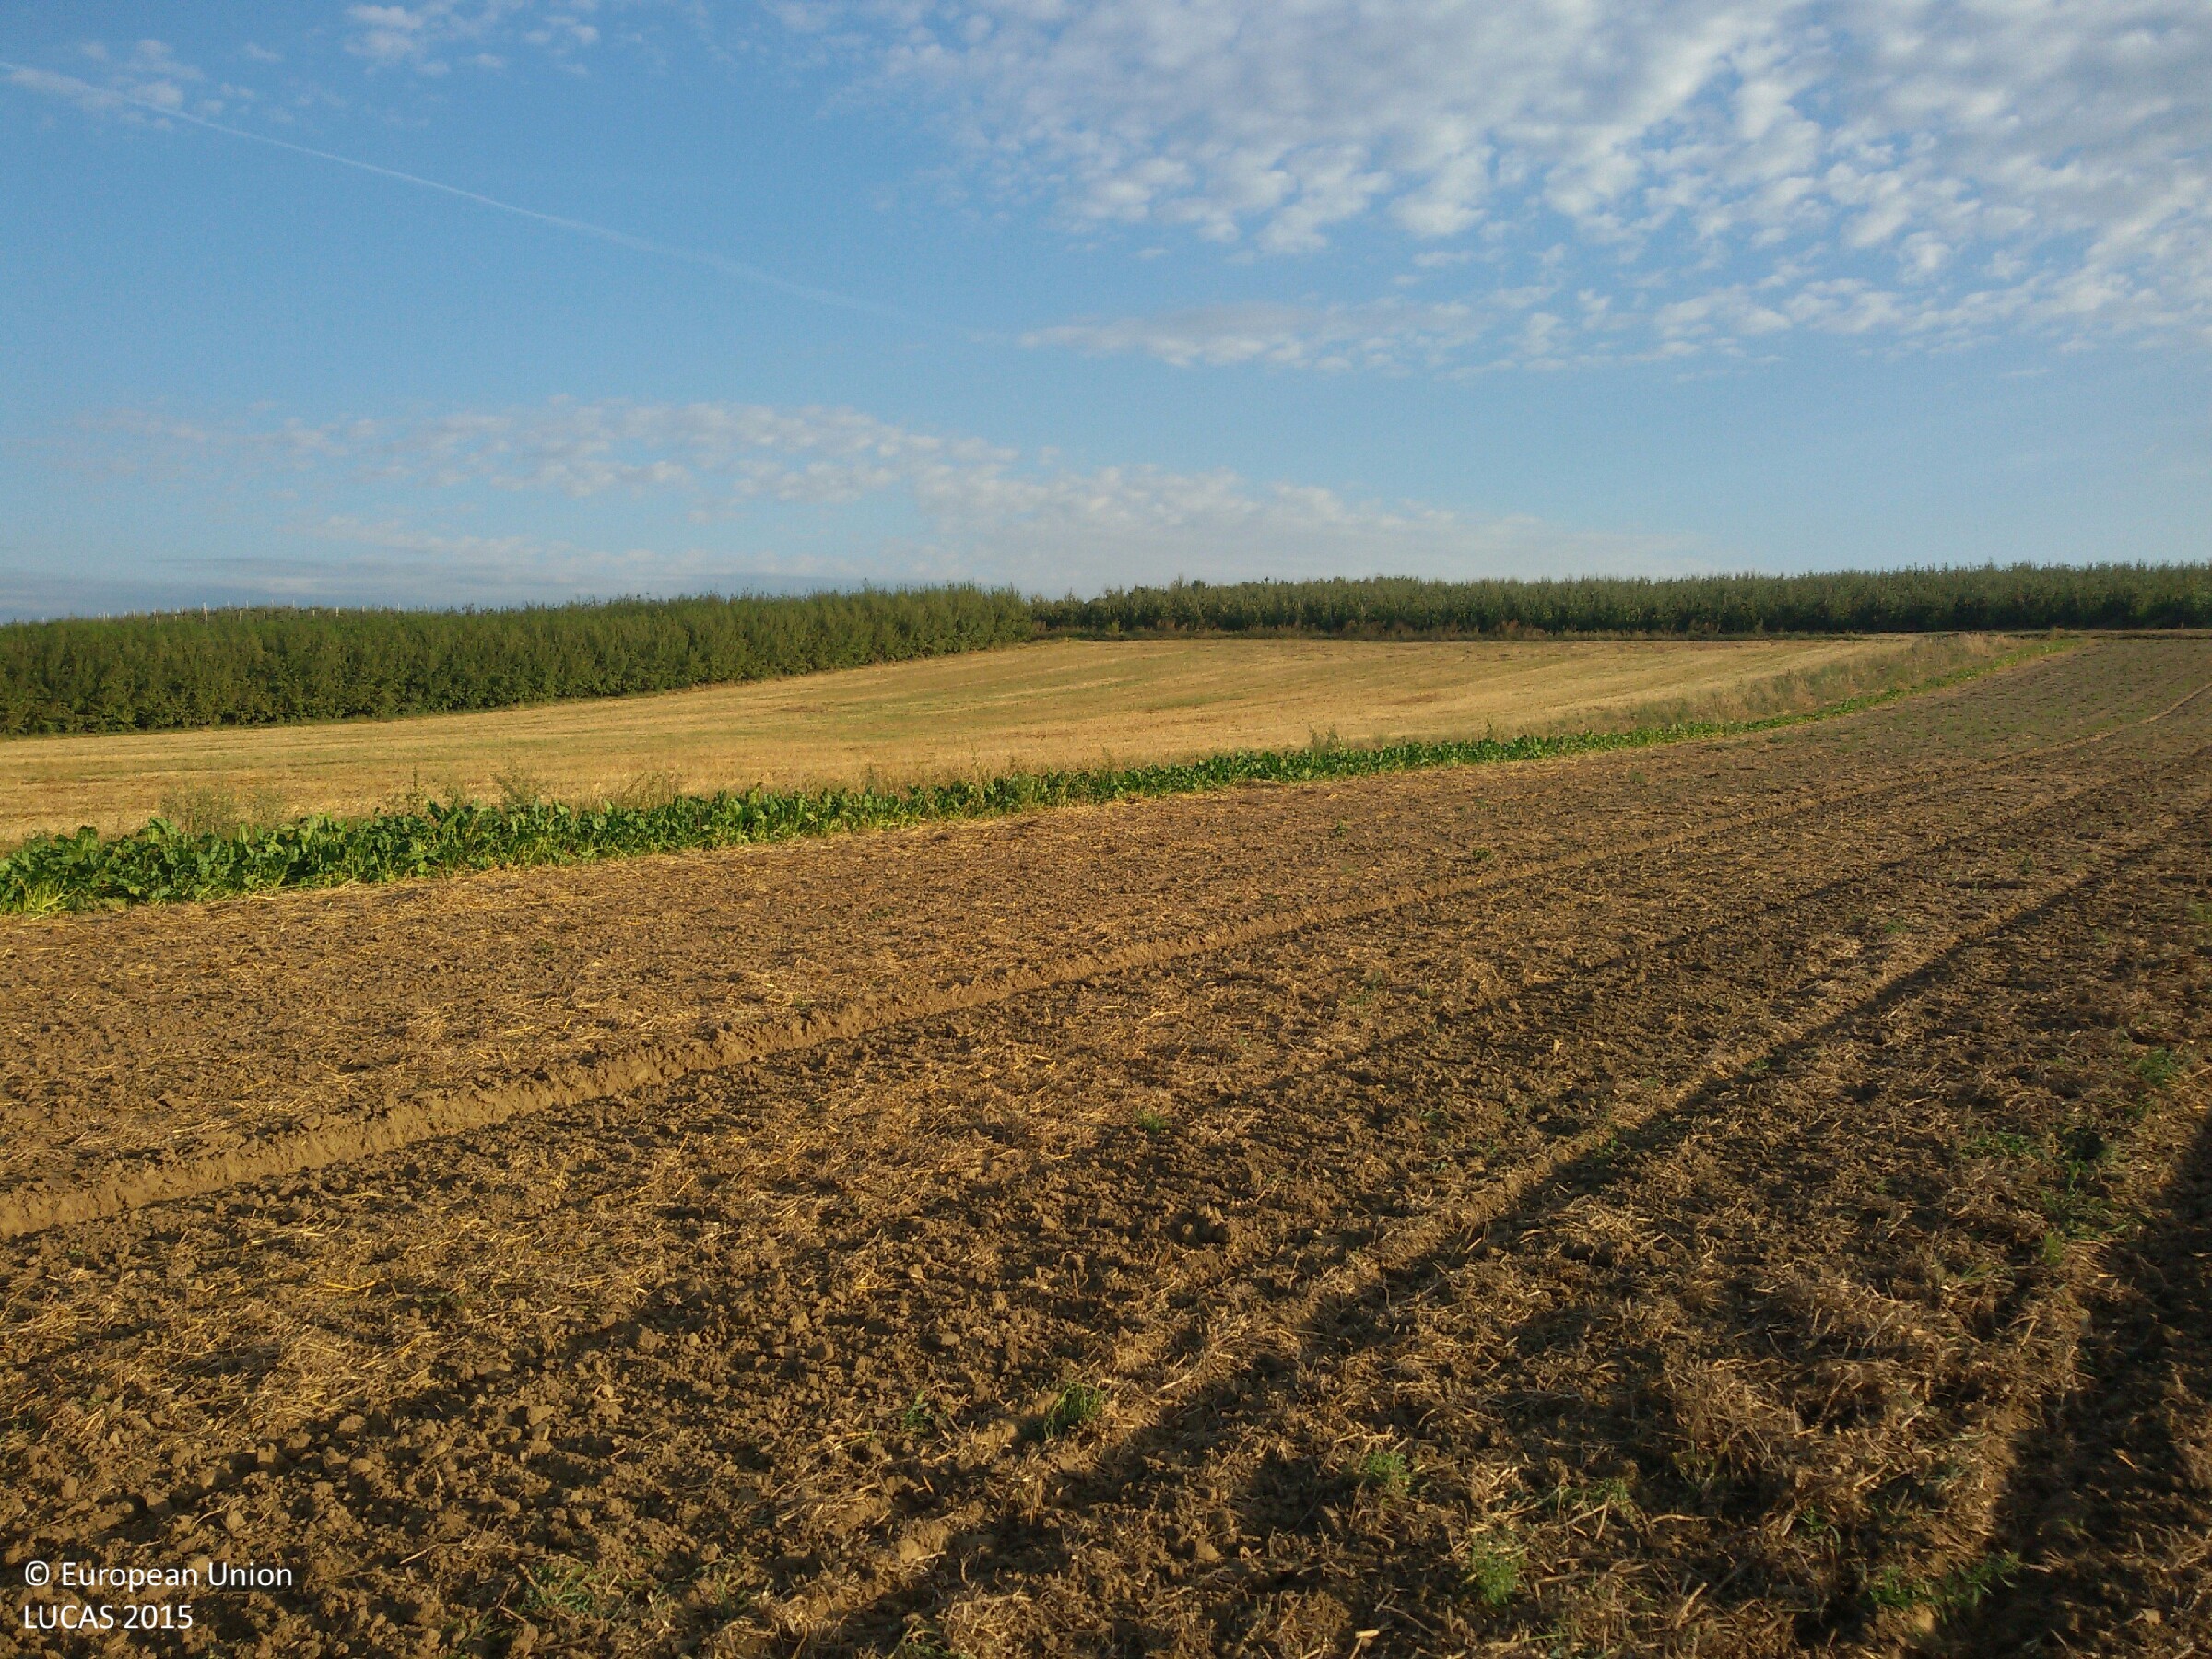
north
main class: Cropland
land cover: Other leguminous and mixtures for fodder
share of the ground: 10 - 25 %
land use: Agriculture (excluding fallow land and kitchen gardens)
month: August
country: PL
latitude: 50.7437
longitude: 21.6884
